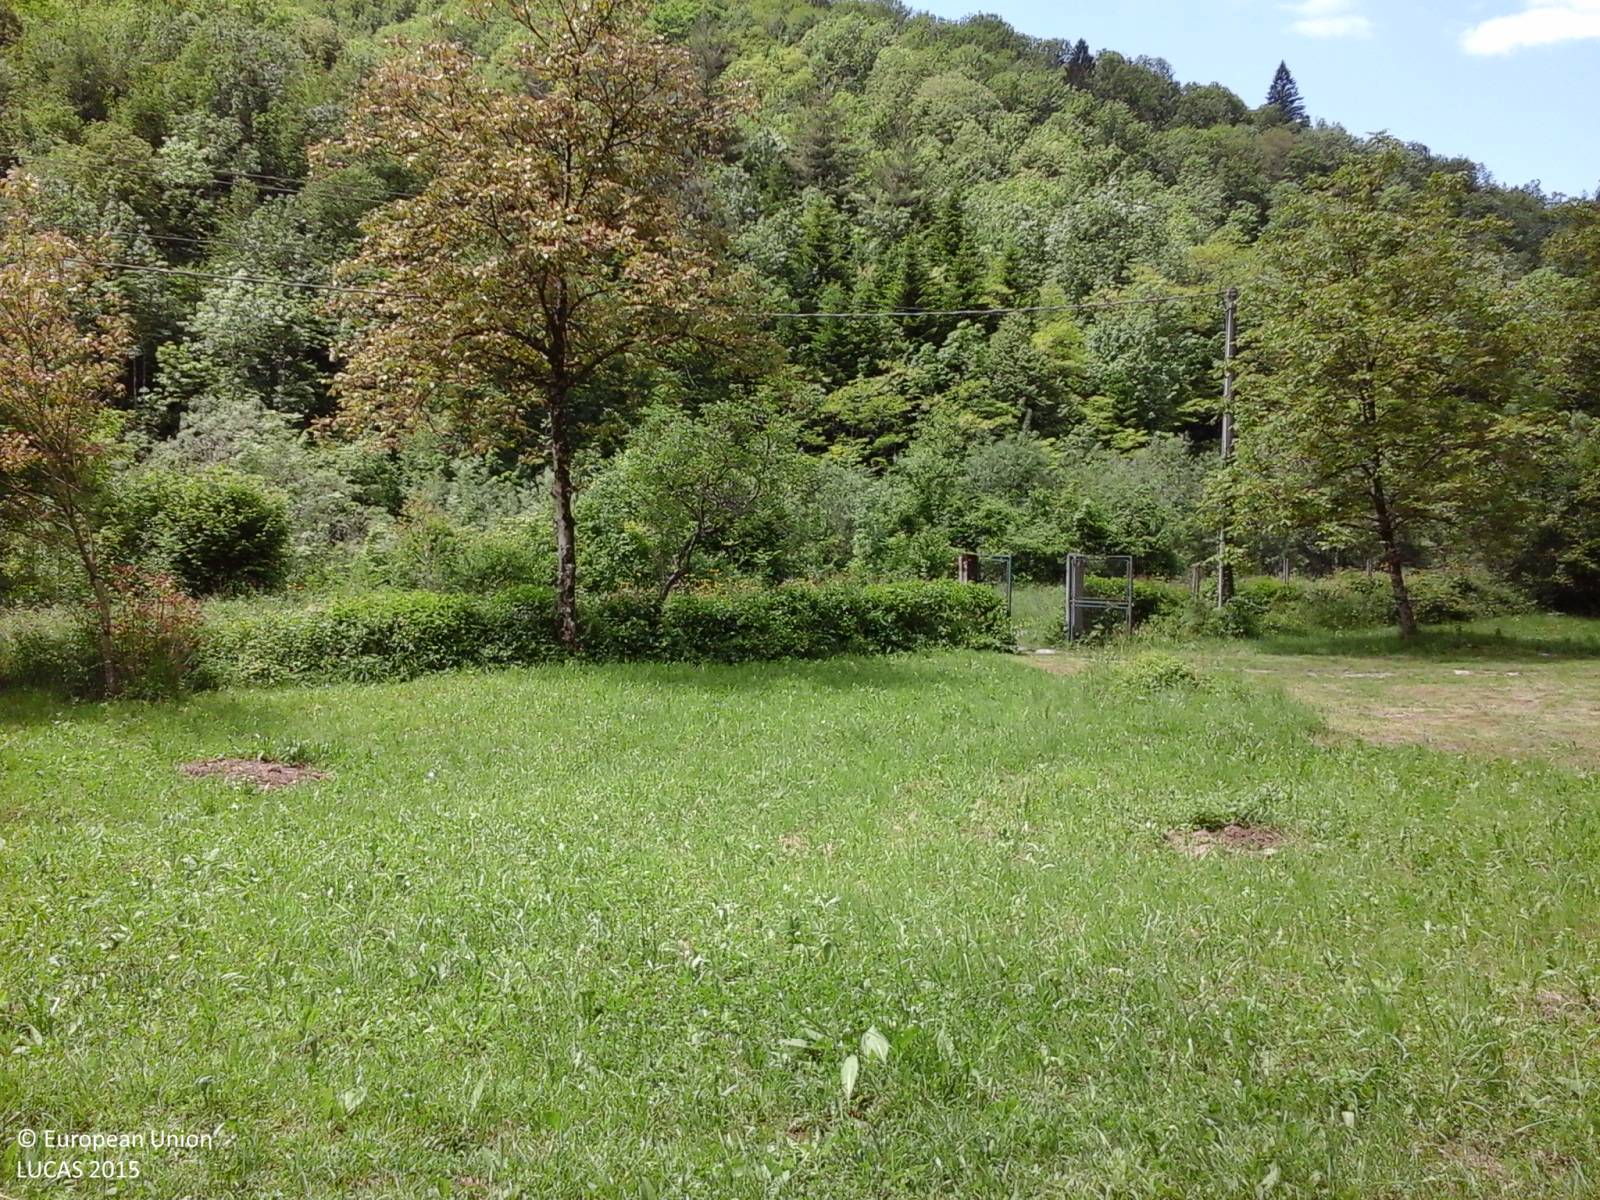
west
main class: Woodland
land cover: Broadleaved woodland
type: thermophilous deciduous forest
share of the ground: > 75 %
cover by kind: broadleaved forest trees 75 %, coniferous forest trees 25 %
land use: Forestry
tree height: > 5 m
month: May
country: IT
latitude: 46.2657
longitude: 13.2533
